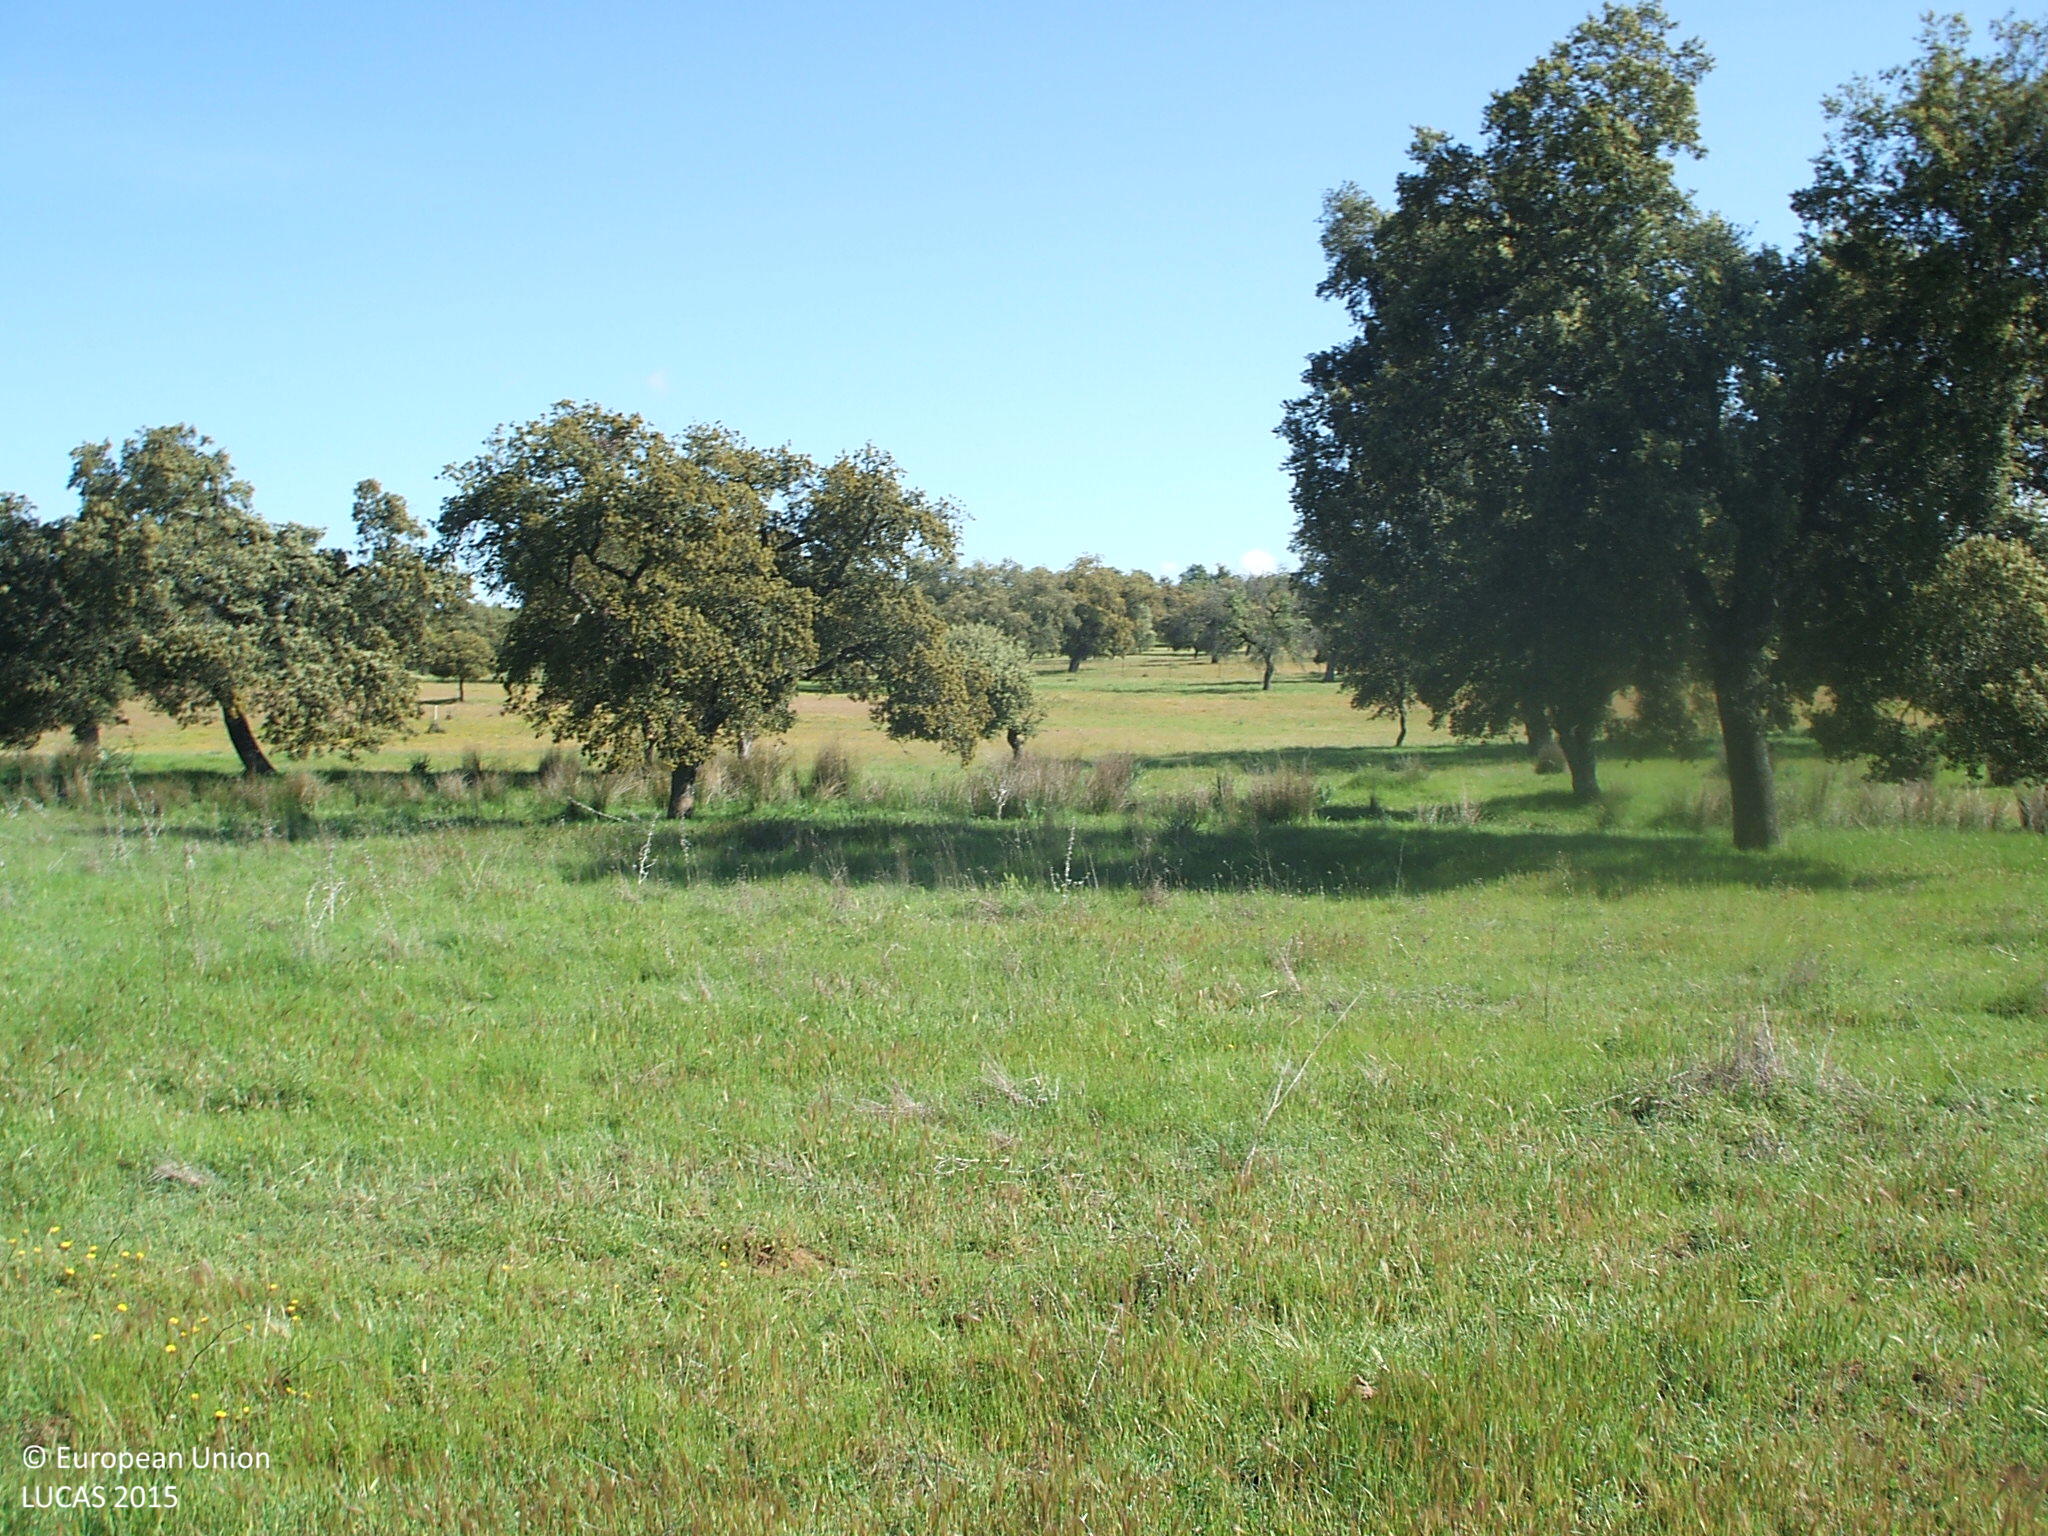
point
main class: Woodland
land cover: Broadleaved woodland
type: broadleaved evergreen forest
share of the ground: 25 - 50 %
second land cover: Grassland without tree/shrub cover
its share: > 75 %
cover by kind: herbaceous plants 75 %, broadleaved forest trees 25 %
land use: Forestry
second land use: Agriculture (excluding fallow land and kitchen gardens)
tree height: > 5 m
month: April
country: ES
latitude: 38.0136
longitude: -5.6221
